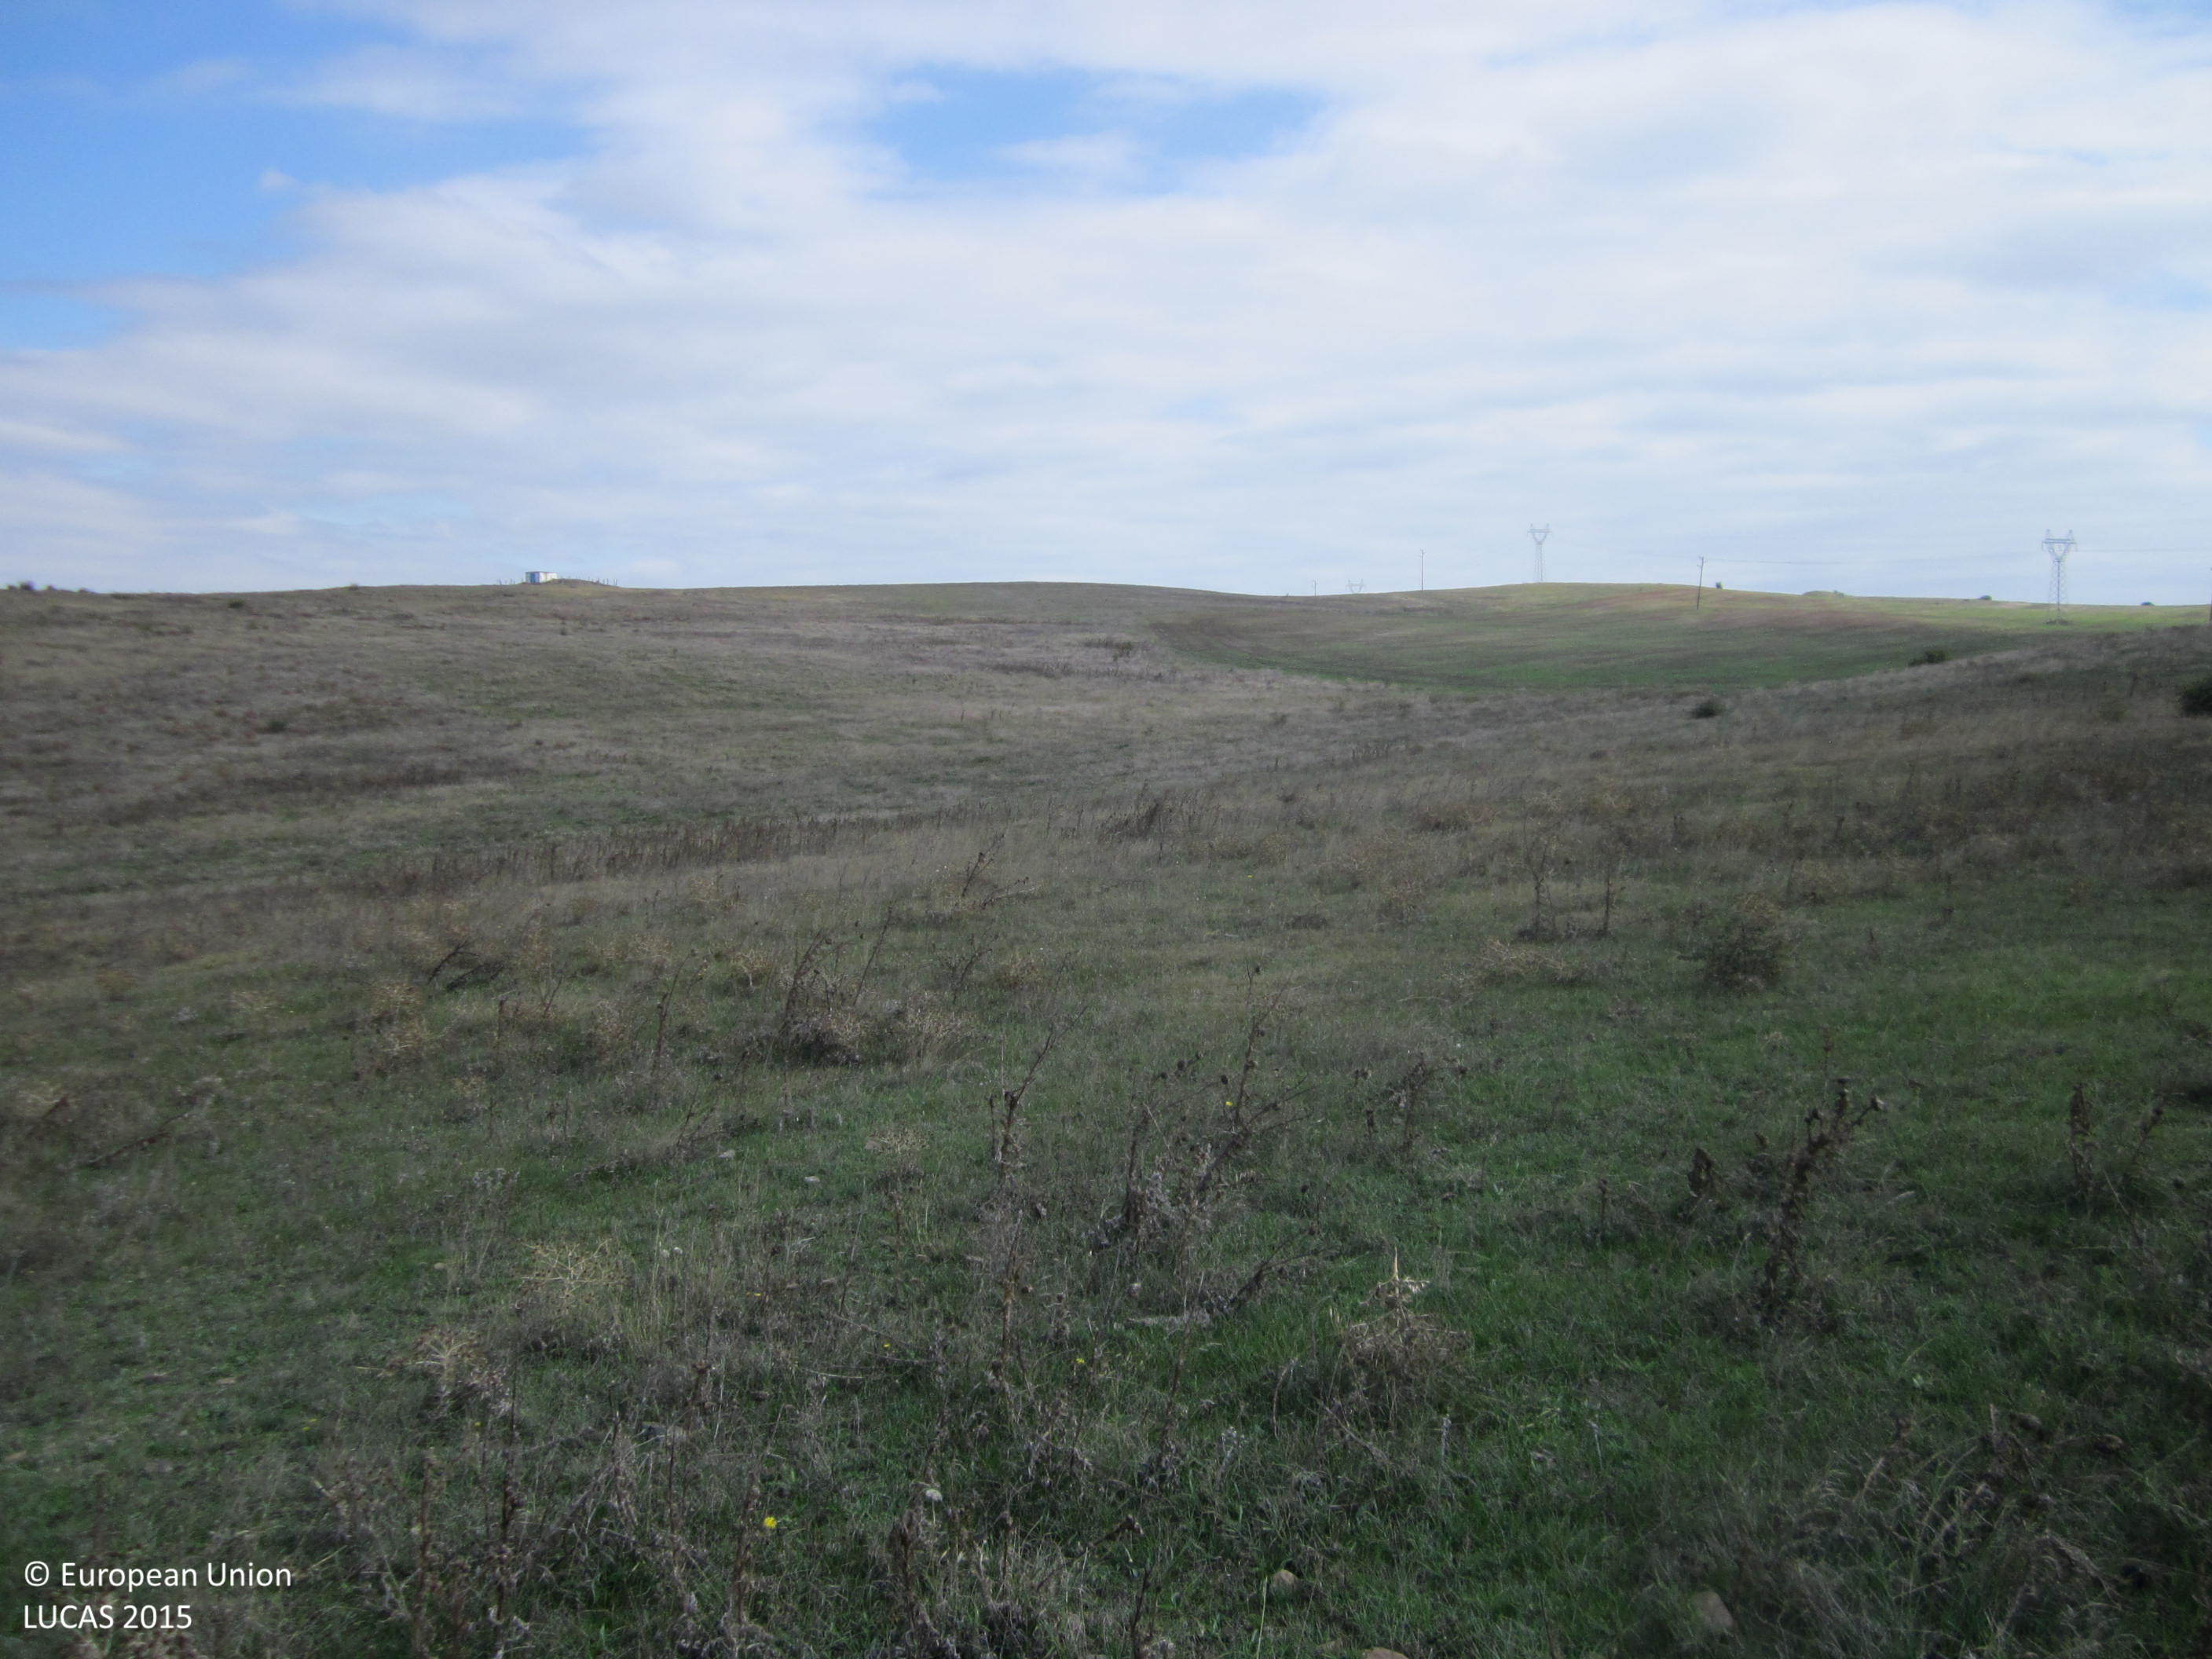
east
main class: Grassland
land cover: Grassland without tree/shrub cover
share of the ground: > 75 %
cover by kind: herbaceous plants 100 %
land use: Agriculture (excluding fallow land and kitchen gardens)
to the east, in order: Grassland without tree/shrub cover
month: October
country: BG
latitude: 42.5951
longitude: 26.8345
